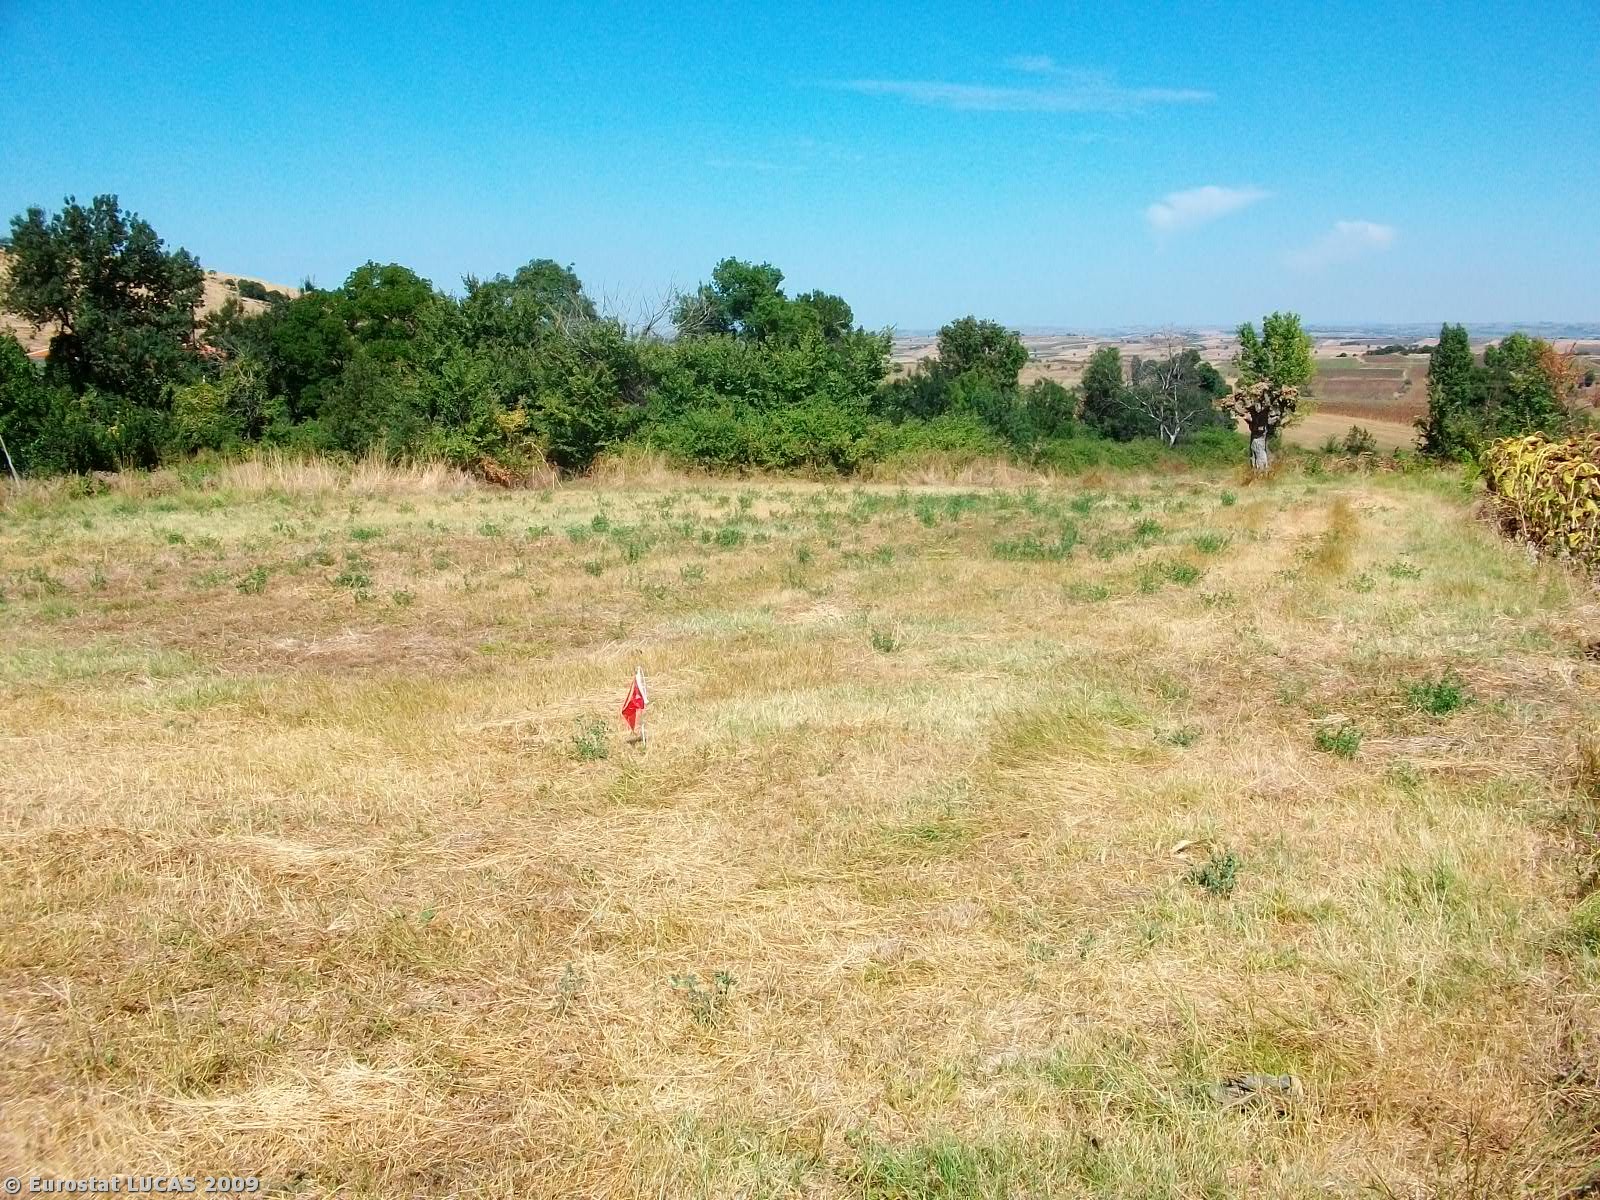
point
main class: Cropland
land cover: Lucerne
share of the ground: < 10 %
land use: Agriculture (excluding fallow land and kitchen gardens)
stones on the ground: < 10 %
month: August
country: GR
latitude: 41.3494
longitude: 26.3639
